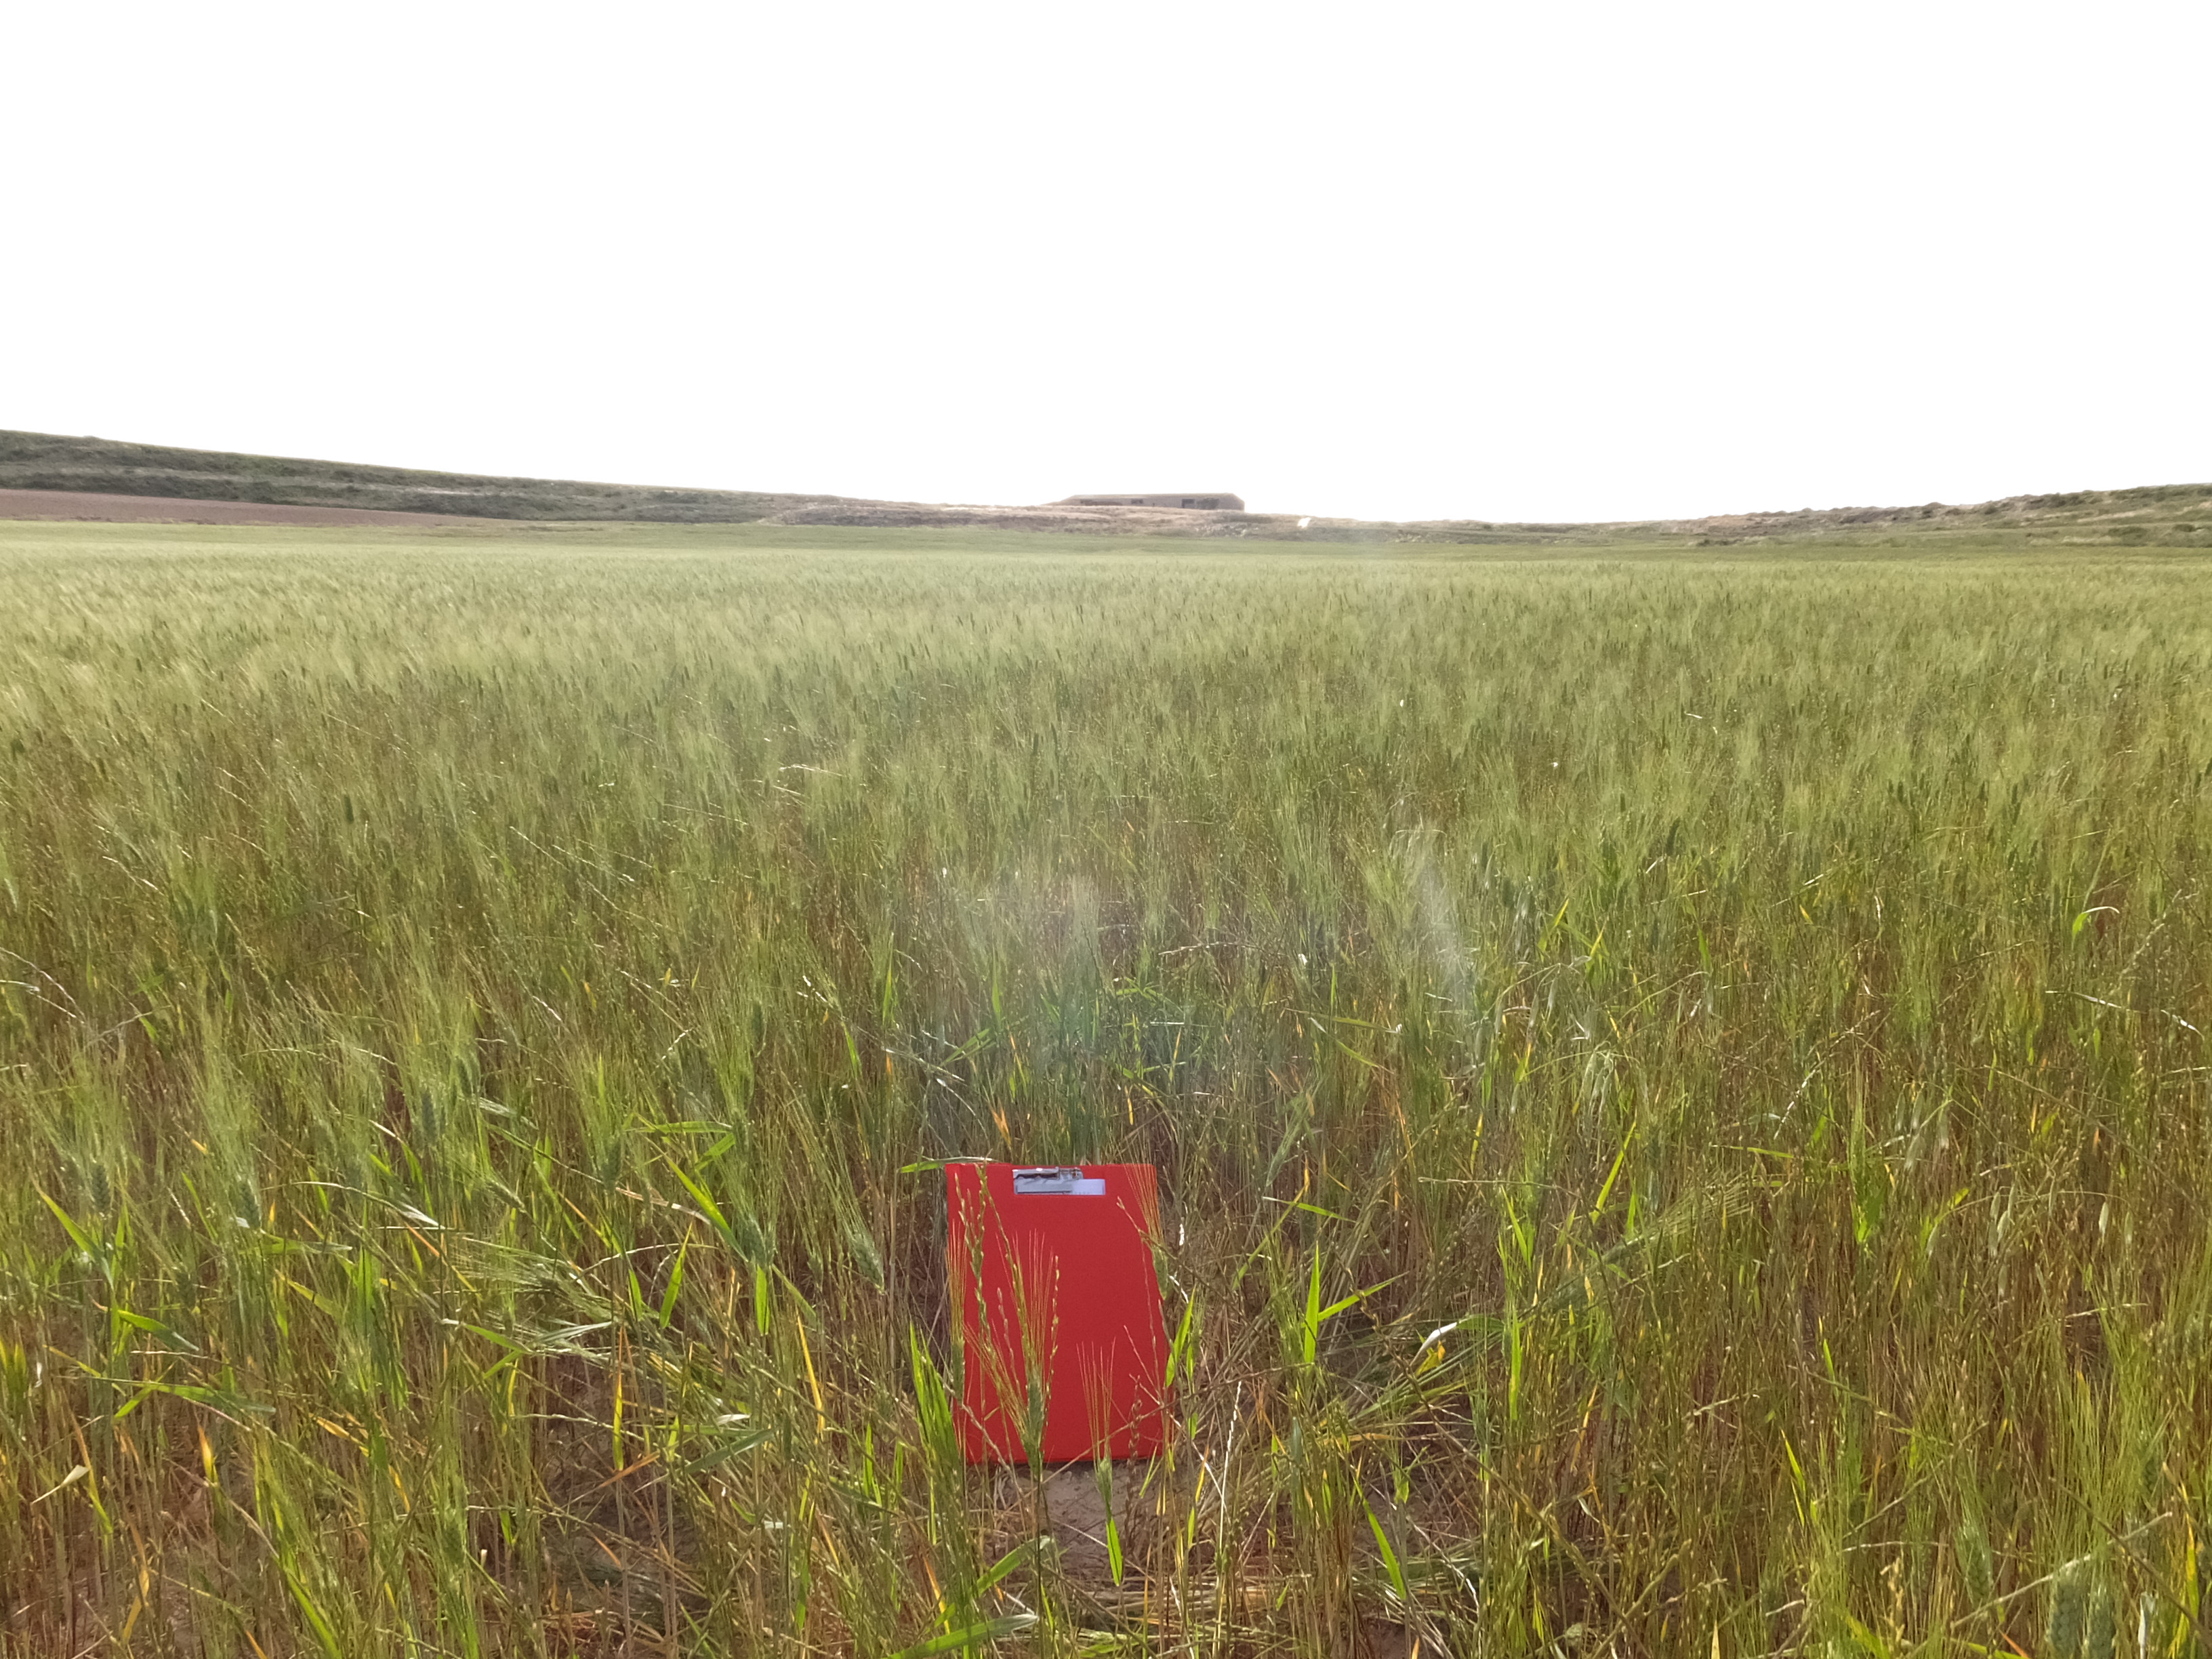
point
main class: Cropland
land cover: Durum wheat
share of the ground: > 75 %
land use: Agriculture (excluding fallow land and kitchen gardens)
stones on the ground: < 10 %
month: May
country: ES
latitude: 41.3698
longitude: -0.2368
